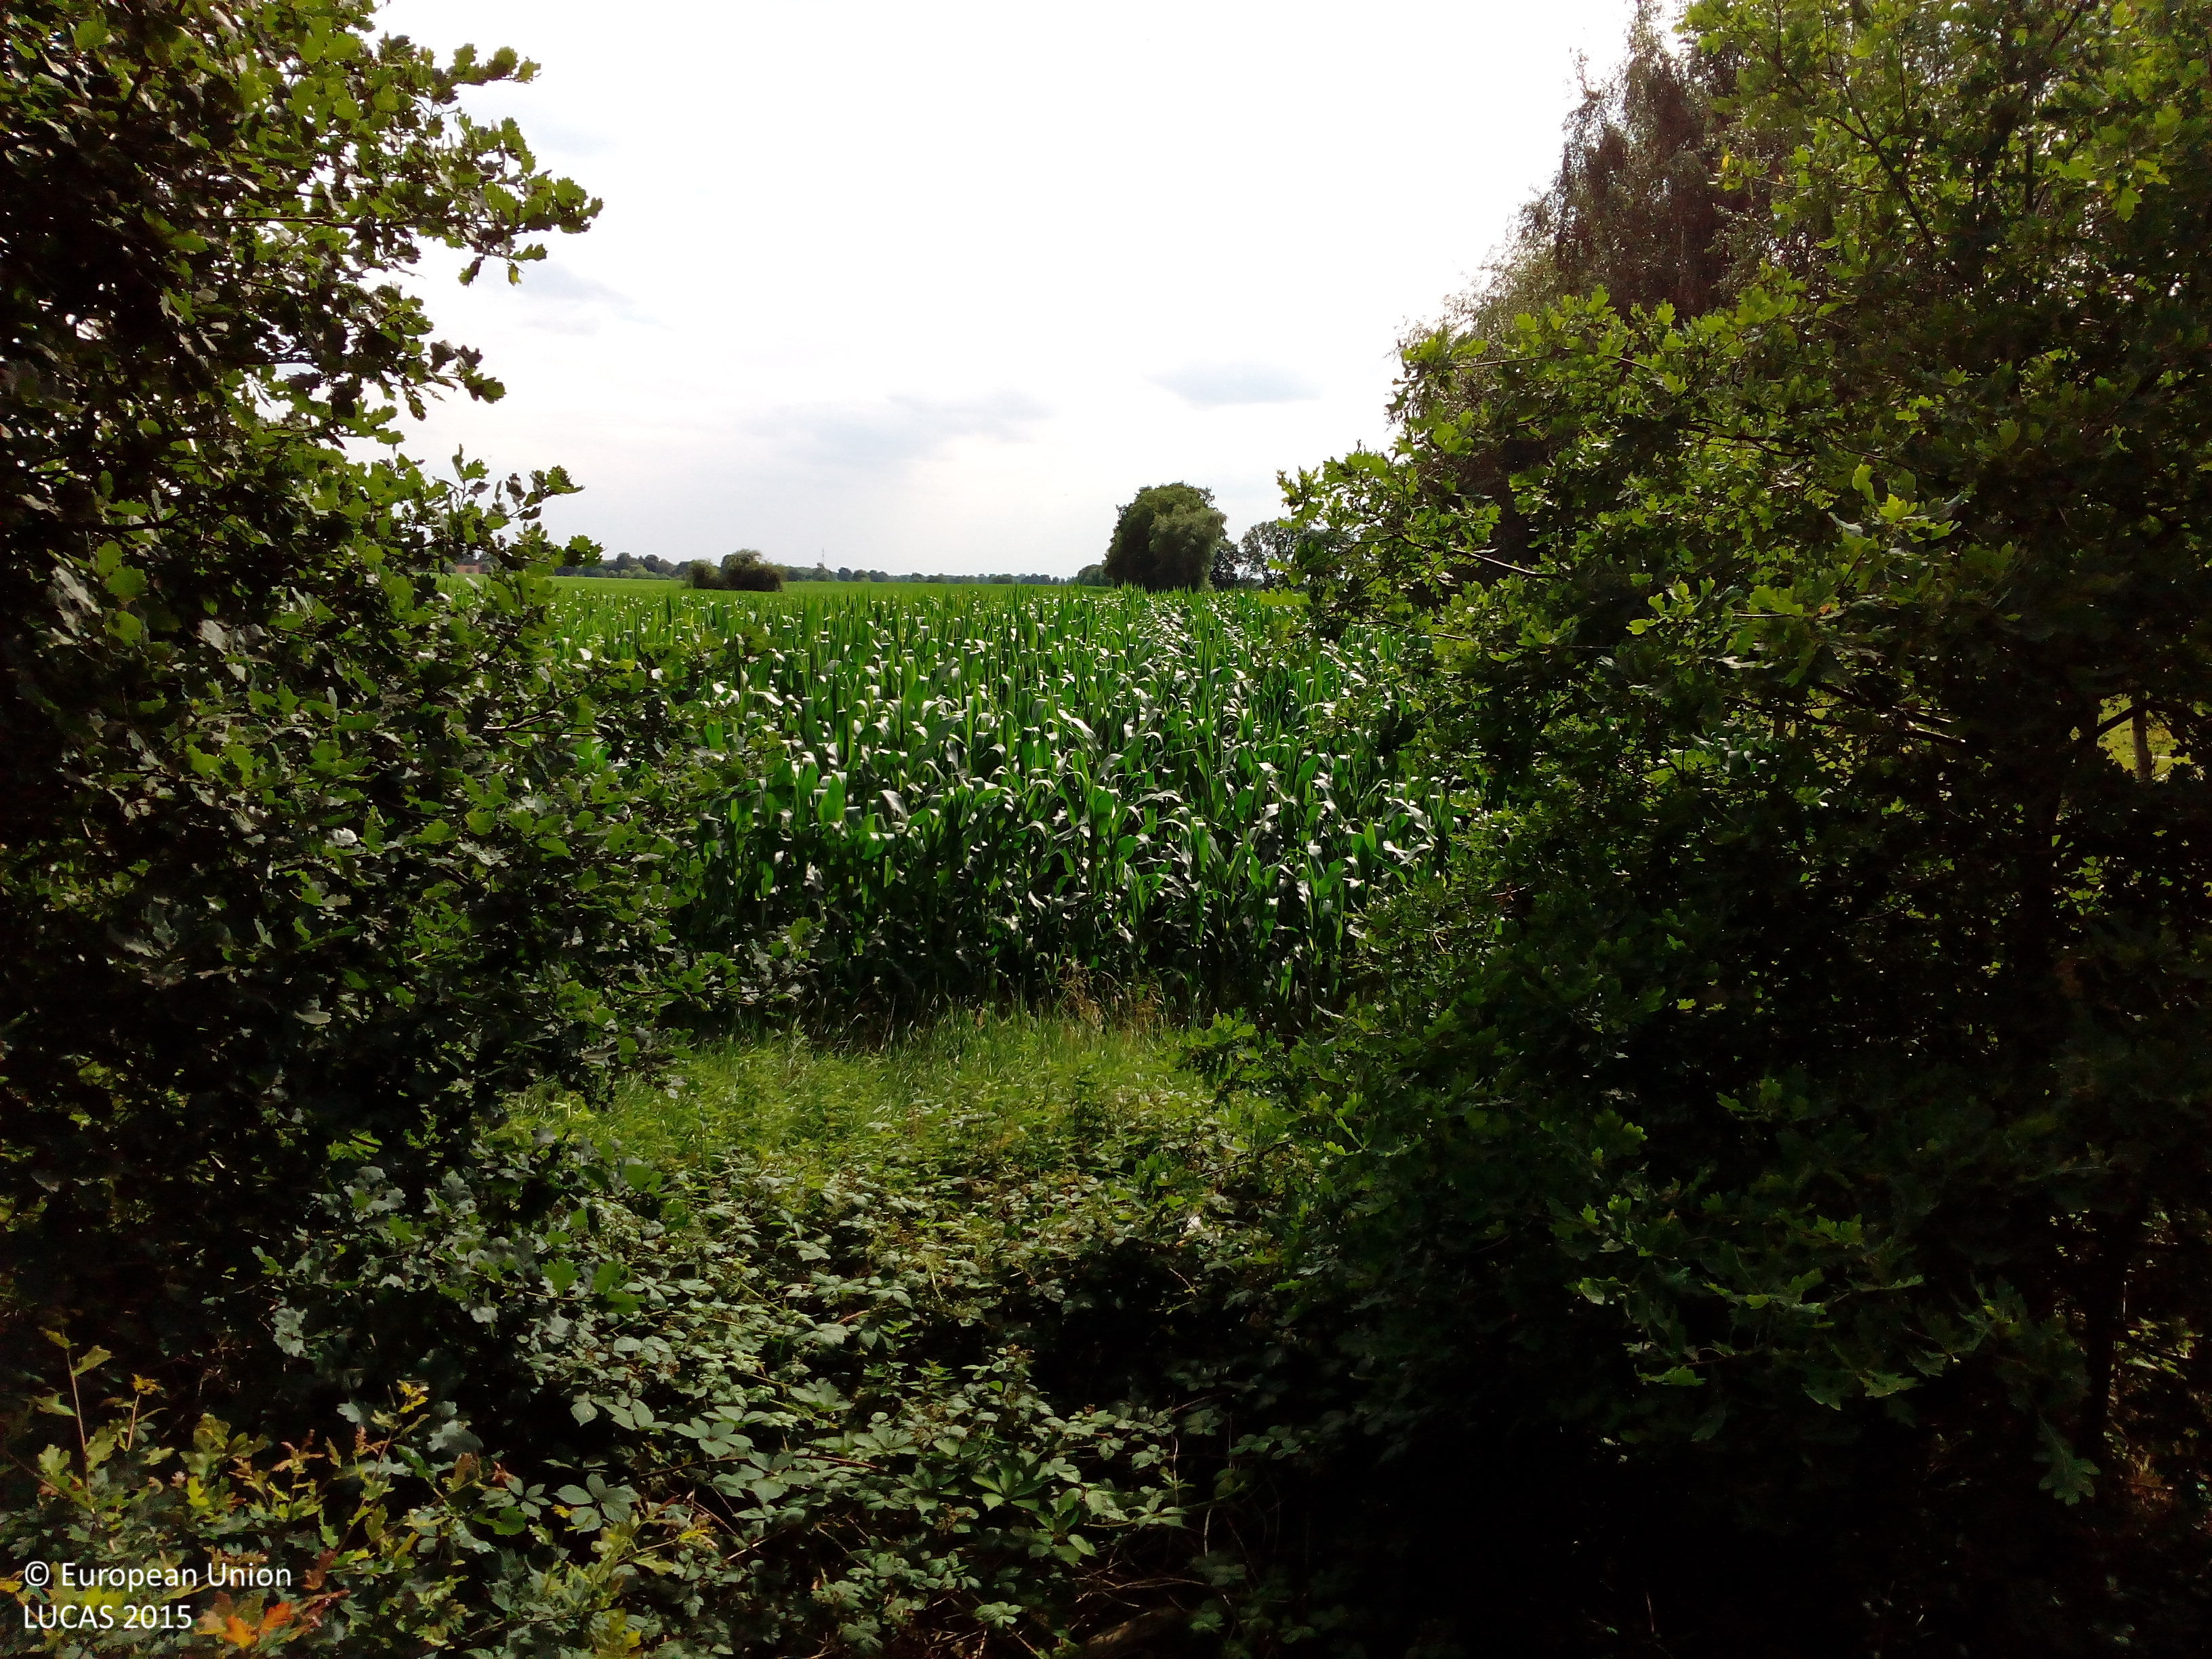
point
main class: Cropland
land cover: Maize
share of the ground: > 75 %
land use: Agriculture (excluding fallow land and kitchen gardens)
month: July
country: DE
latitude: 53.0067
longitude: 7.9291
